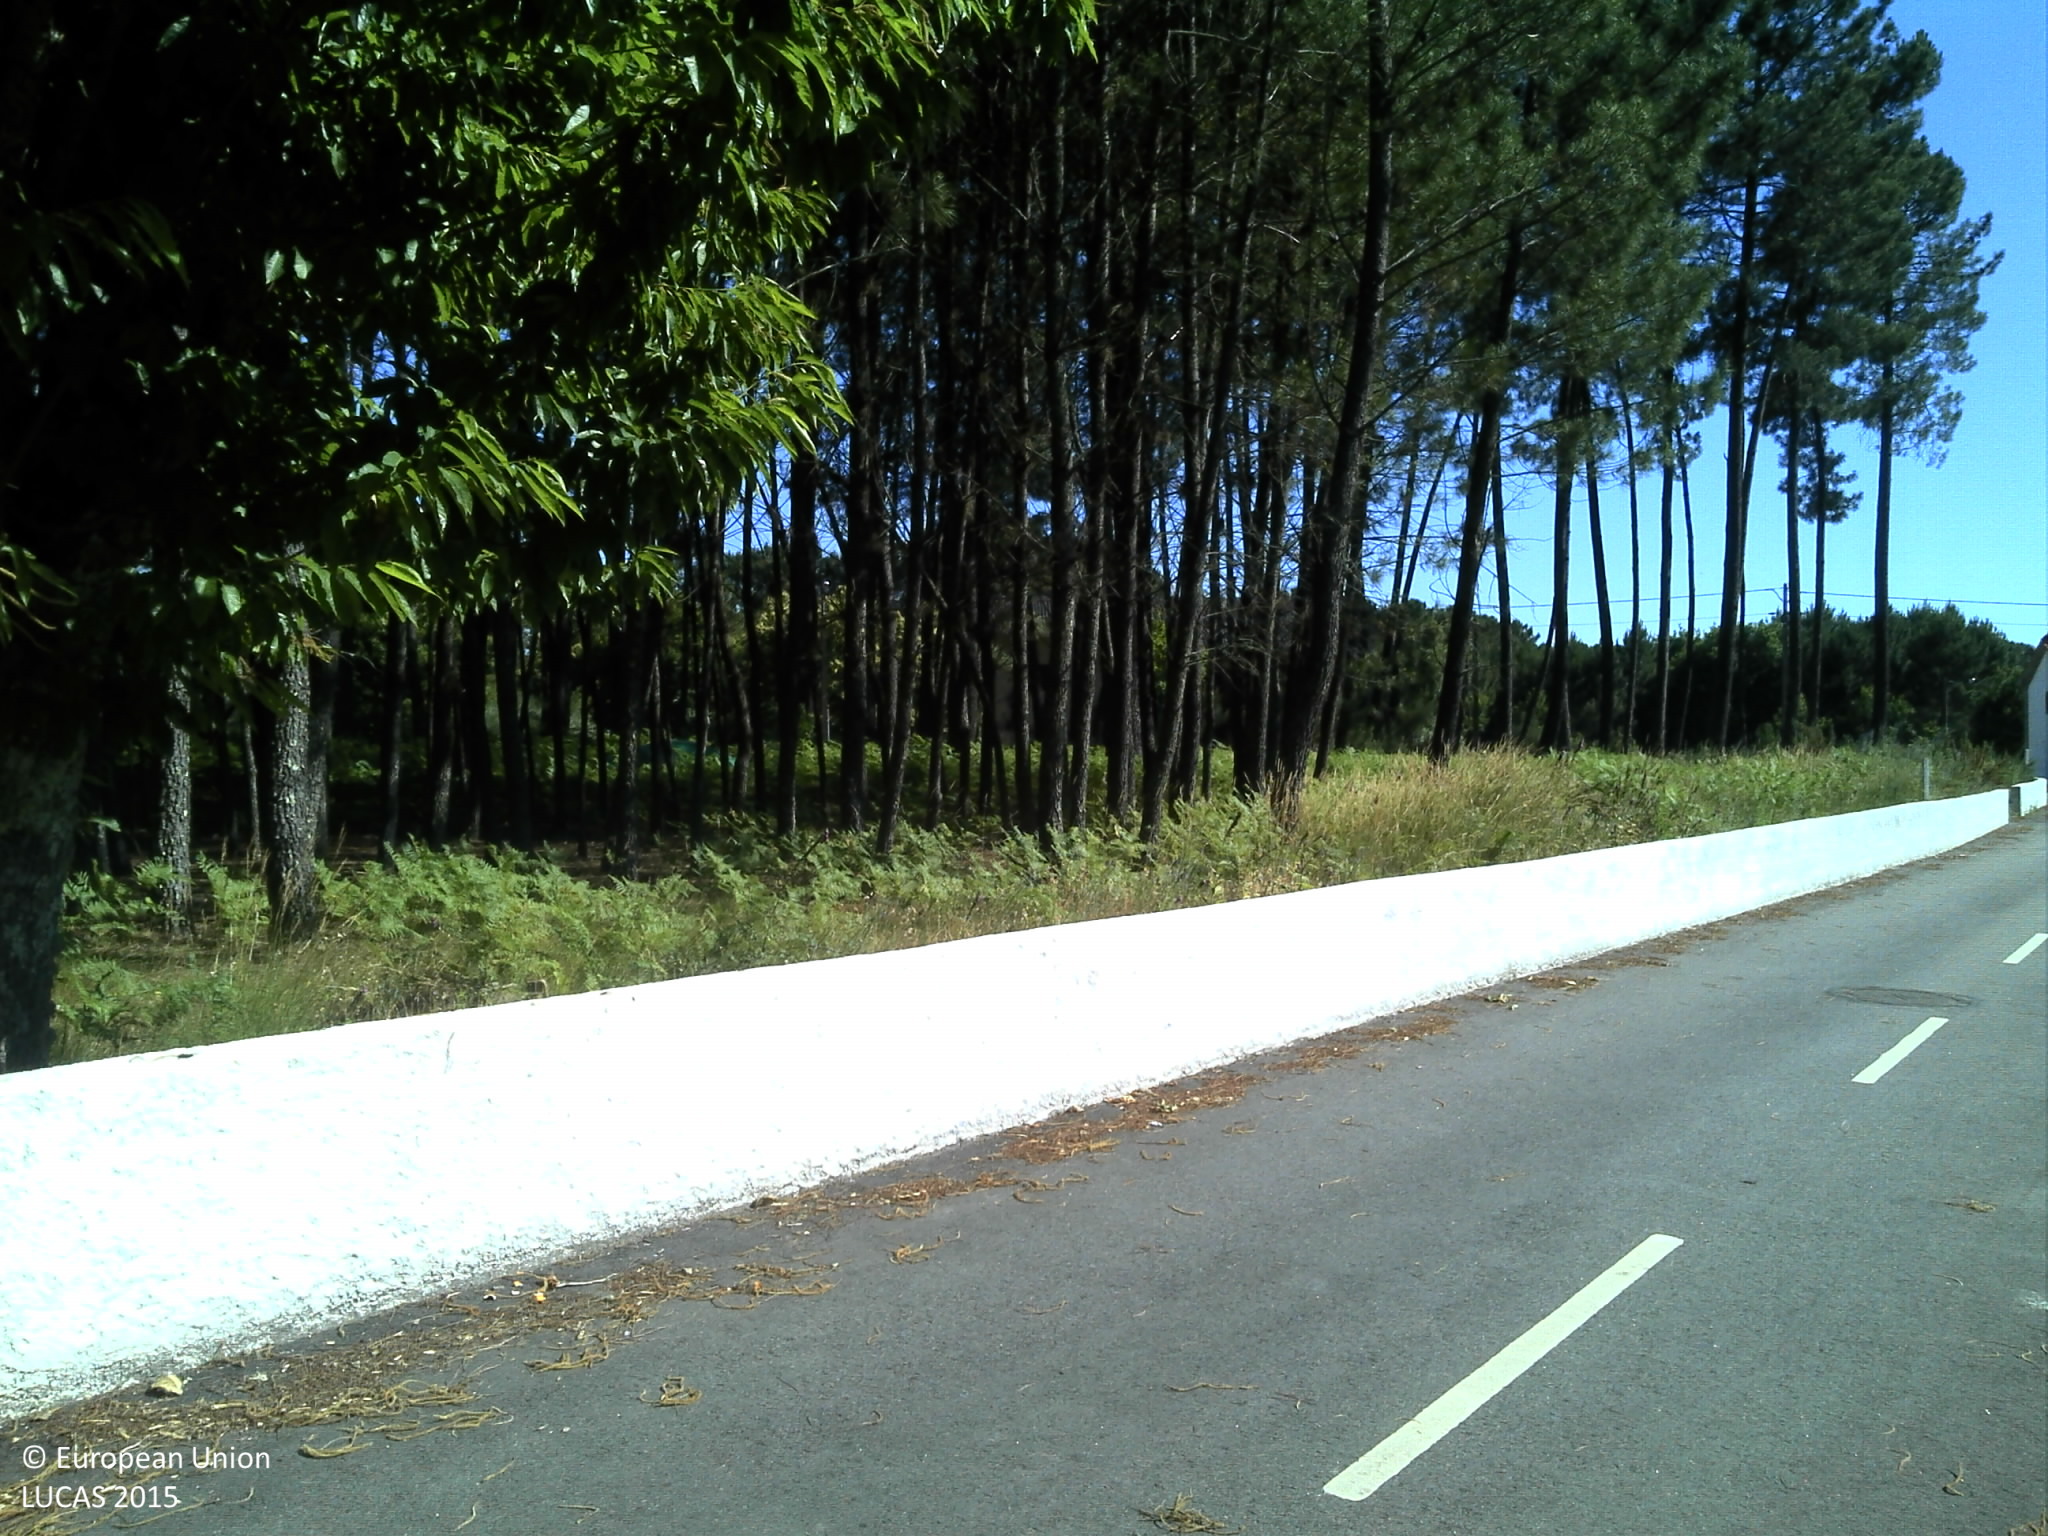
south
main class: Cropland
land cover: Potatoes
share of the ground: > 75 %
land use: Agriculture (excluding fallow land and kitchen gardens)
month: June
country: PT
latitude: 40.7306
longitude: -7.8977
